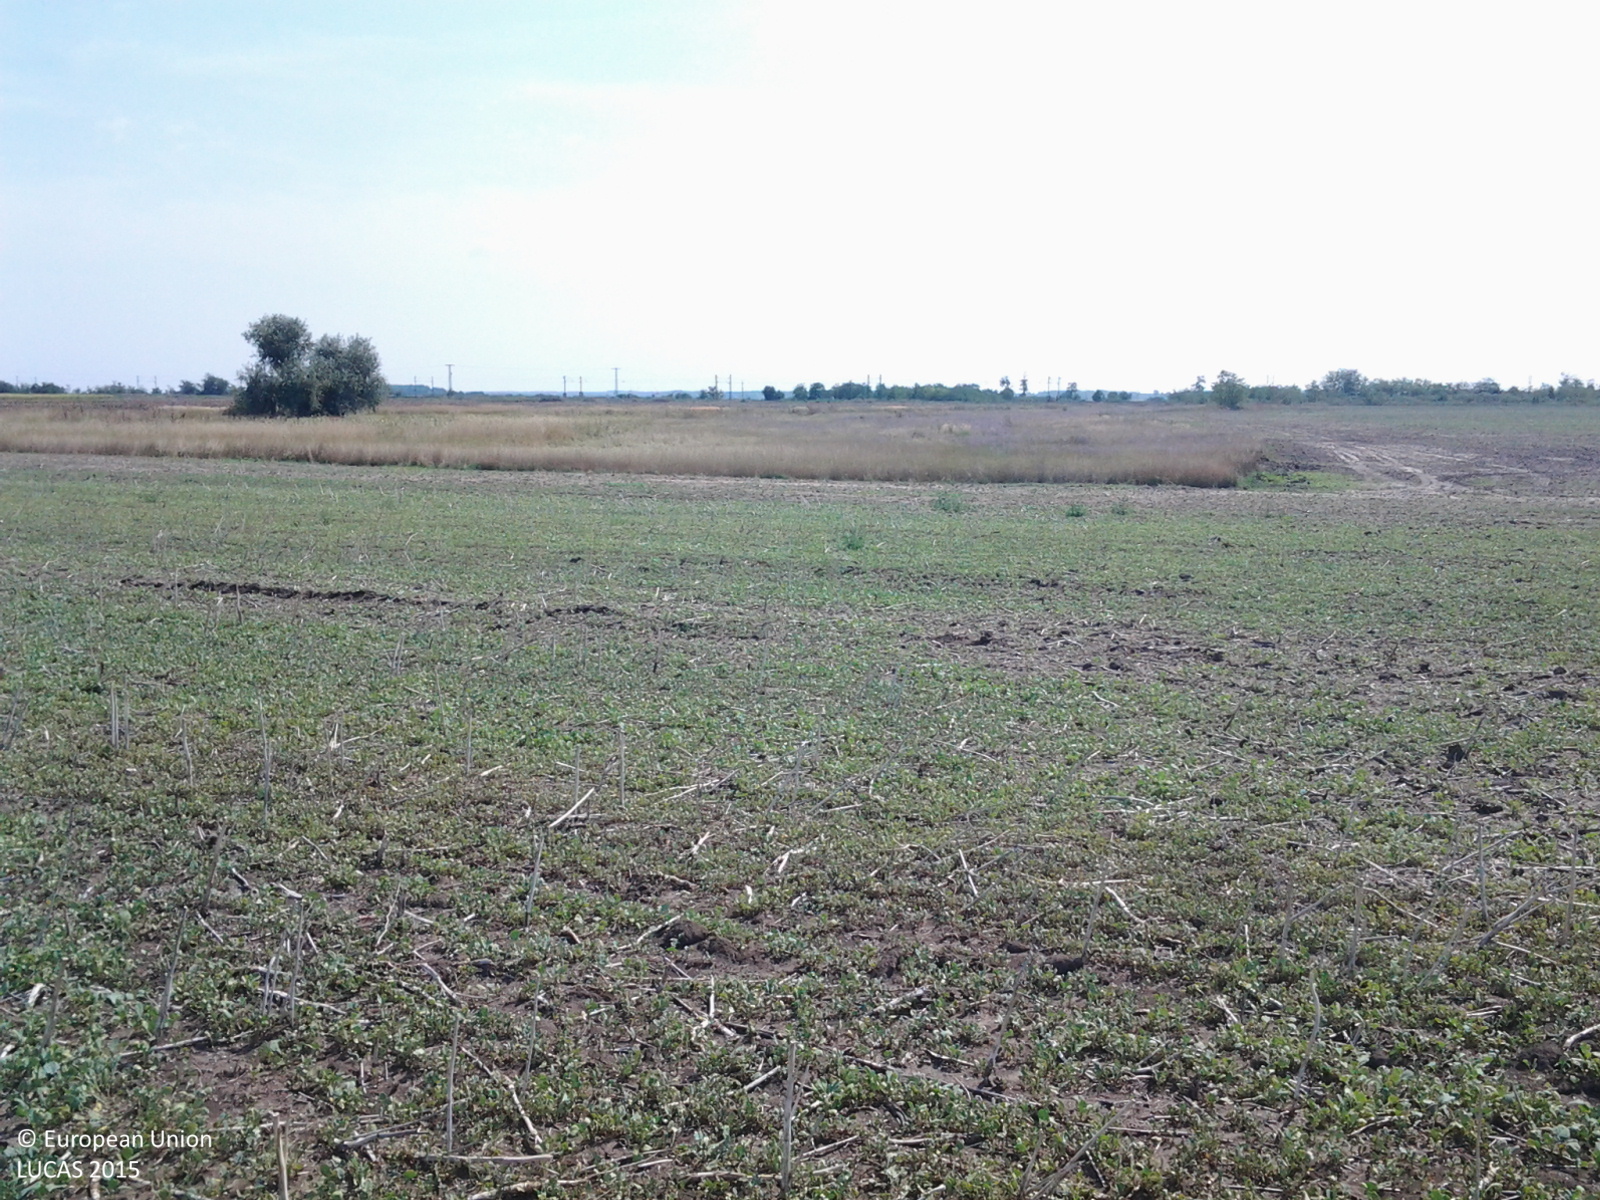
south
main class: Cropland
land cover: Other fibre and oleaginous crops
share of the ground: > 75 %
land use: Agriculture (excluding fallow land and kitchen gardens)
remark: Harvested field
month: August
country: HU
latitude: 47.3407
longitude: 19.9113
